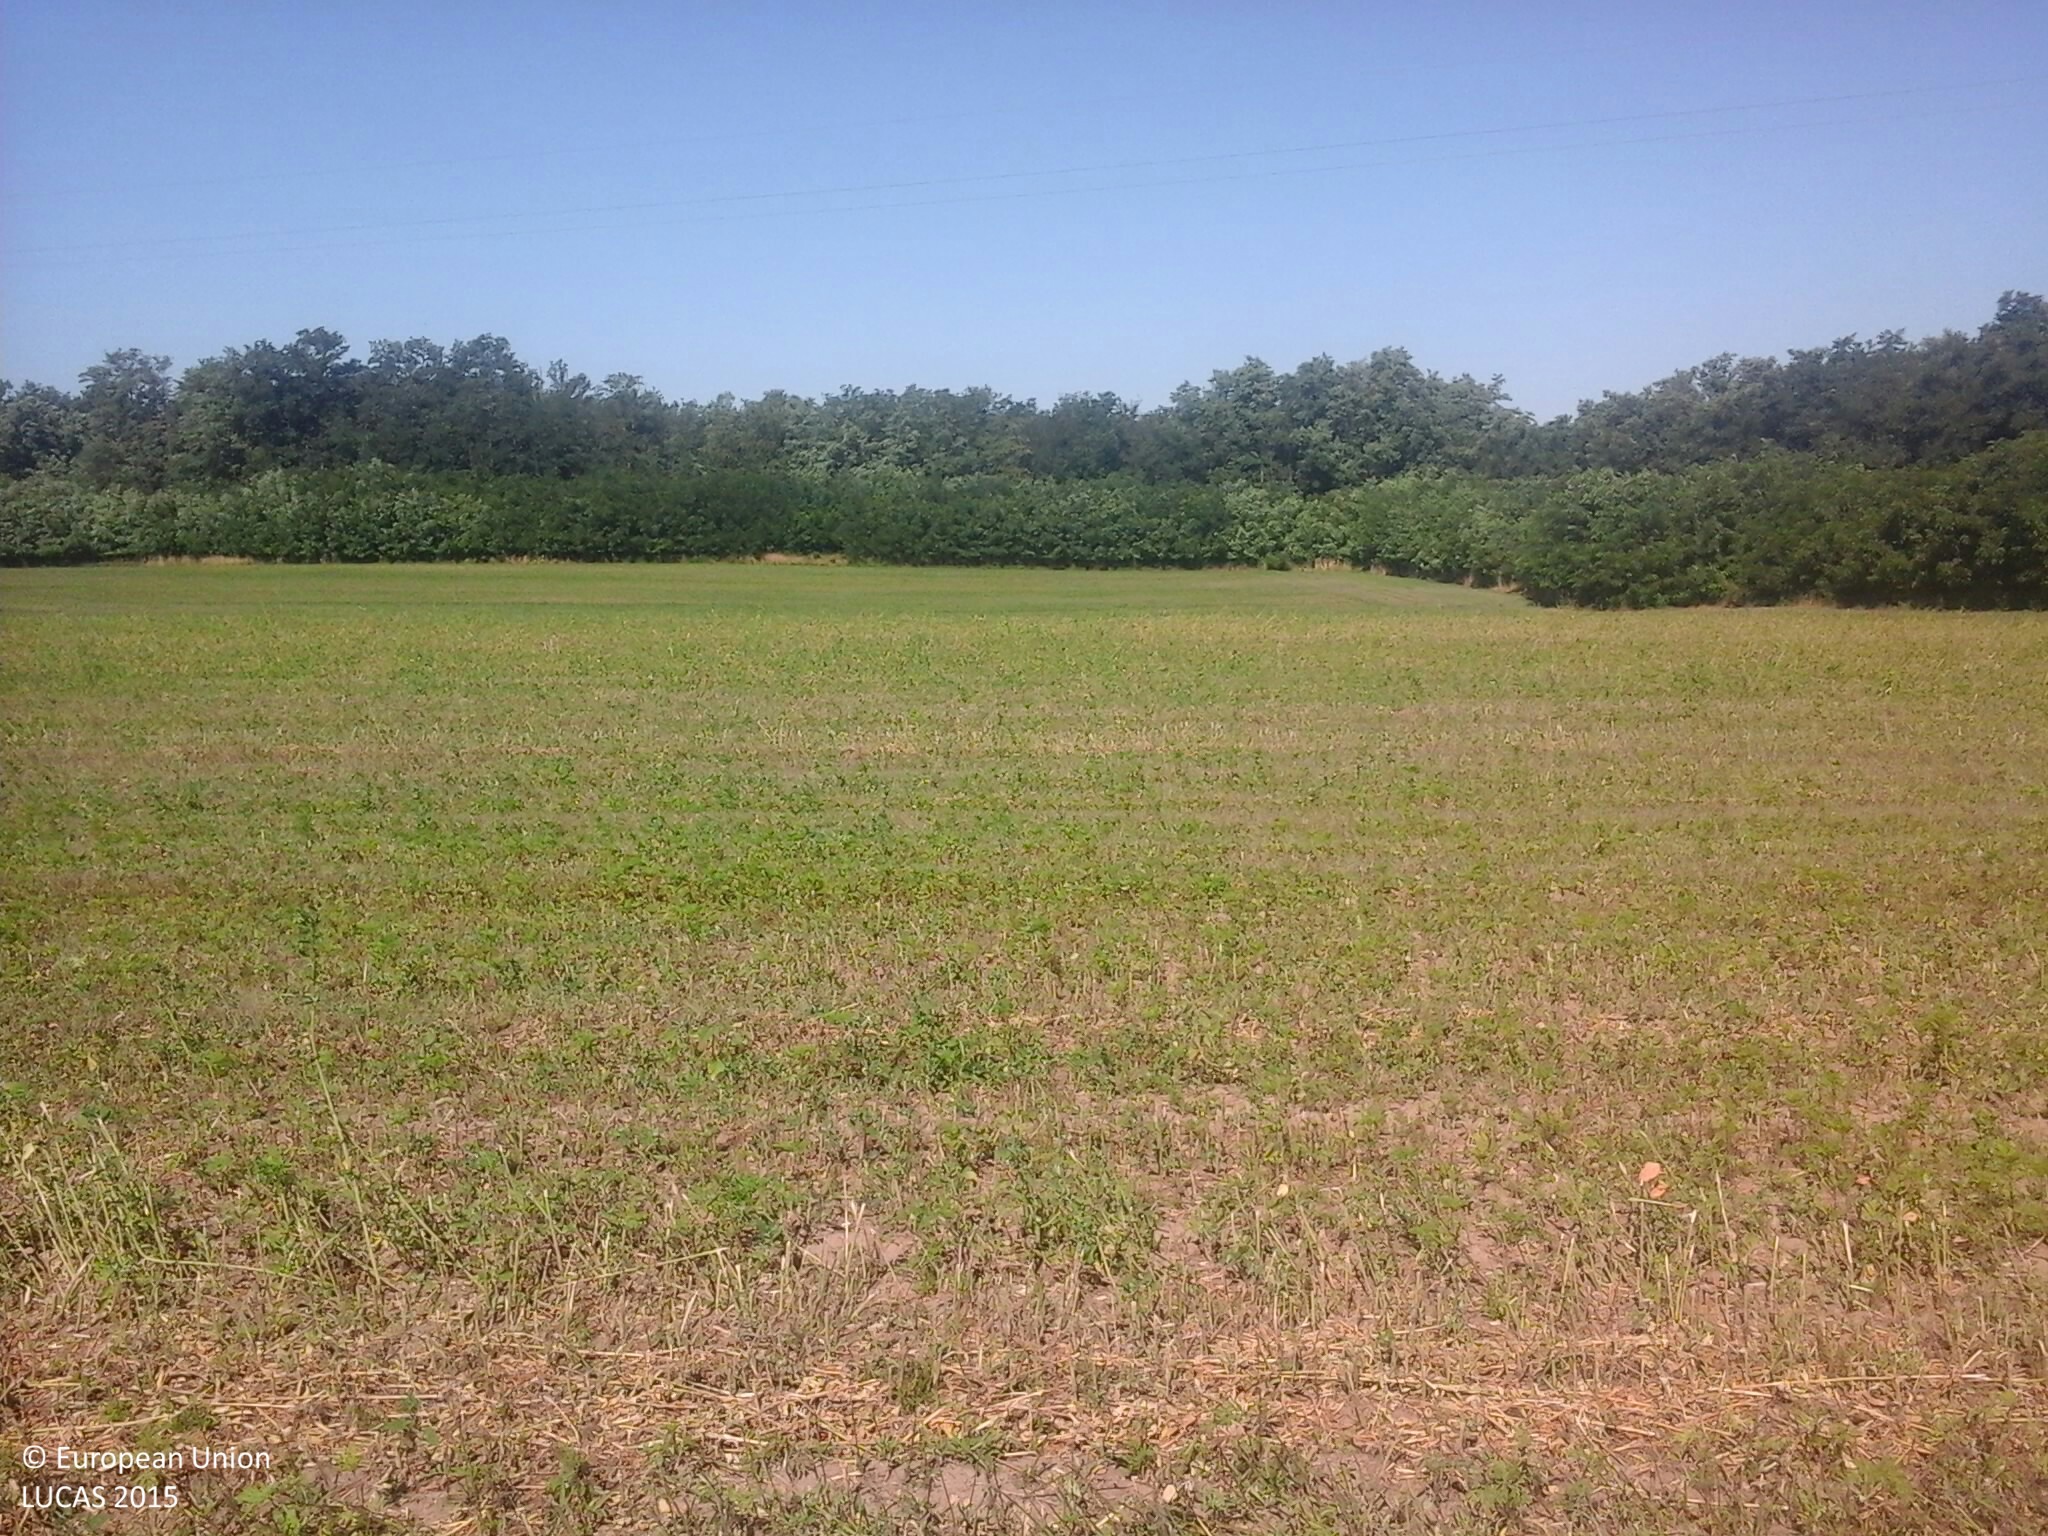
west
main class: Cropland
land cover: Lucerne
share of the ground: > 75 %
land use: Agriculture (excluding fallow land and kitchen gardens)
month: July
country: HU
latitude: 47.8842
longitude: 21.9119
